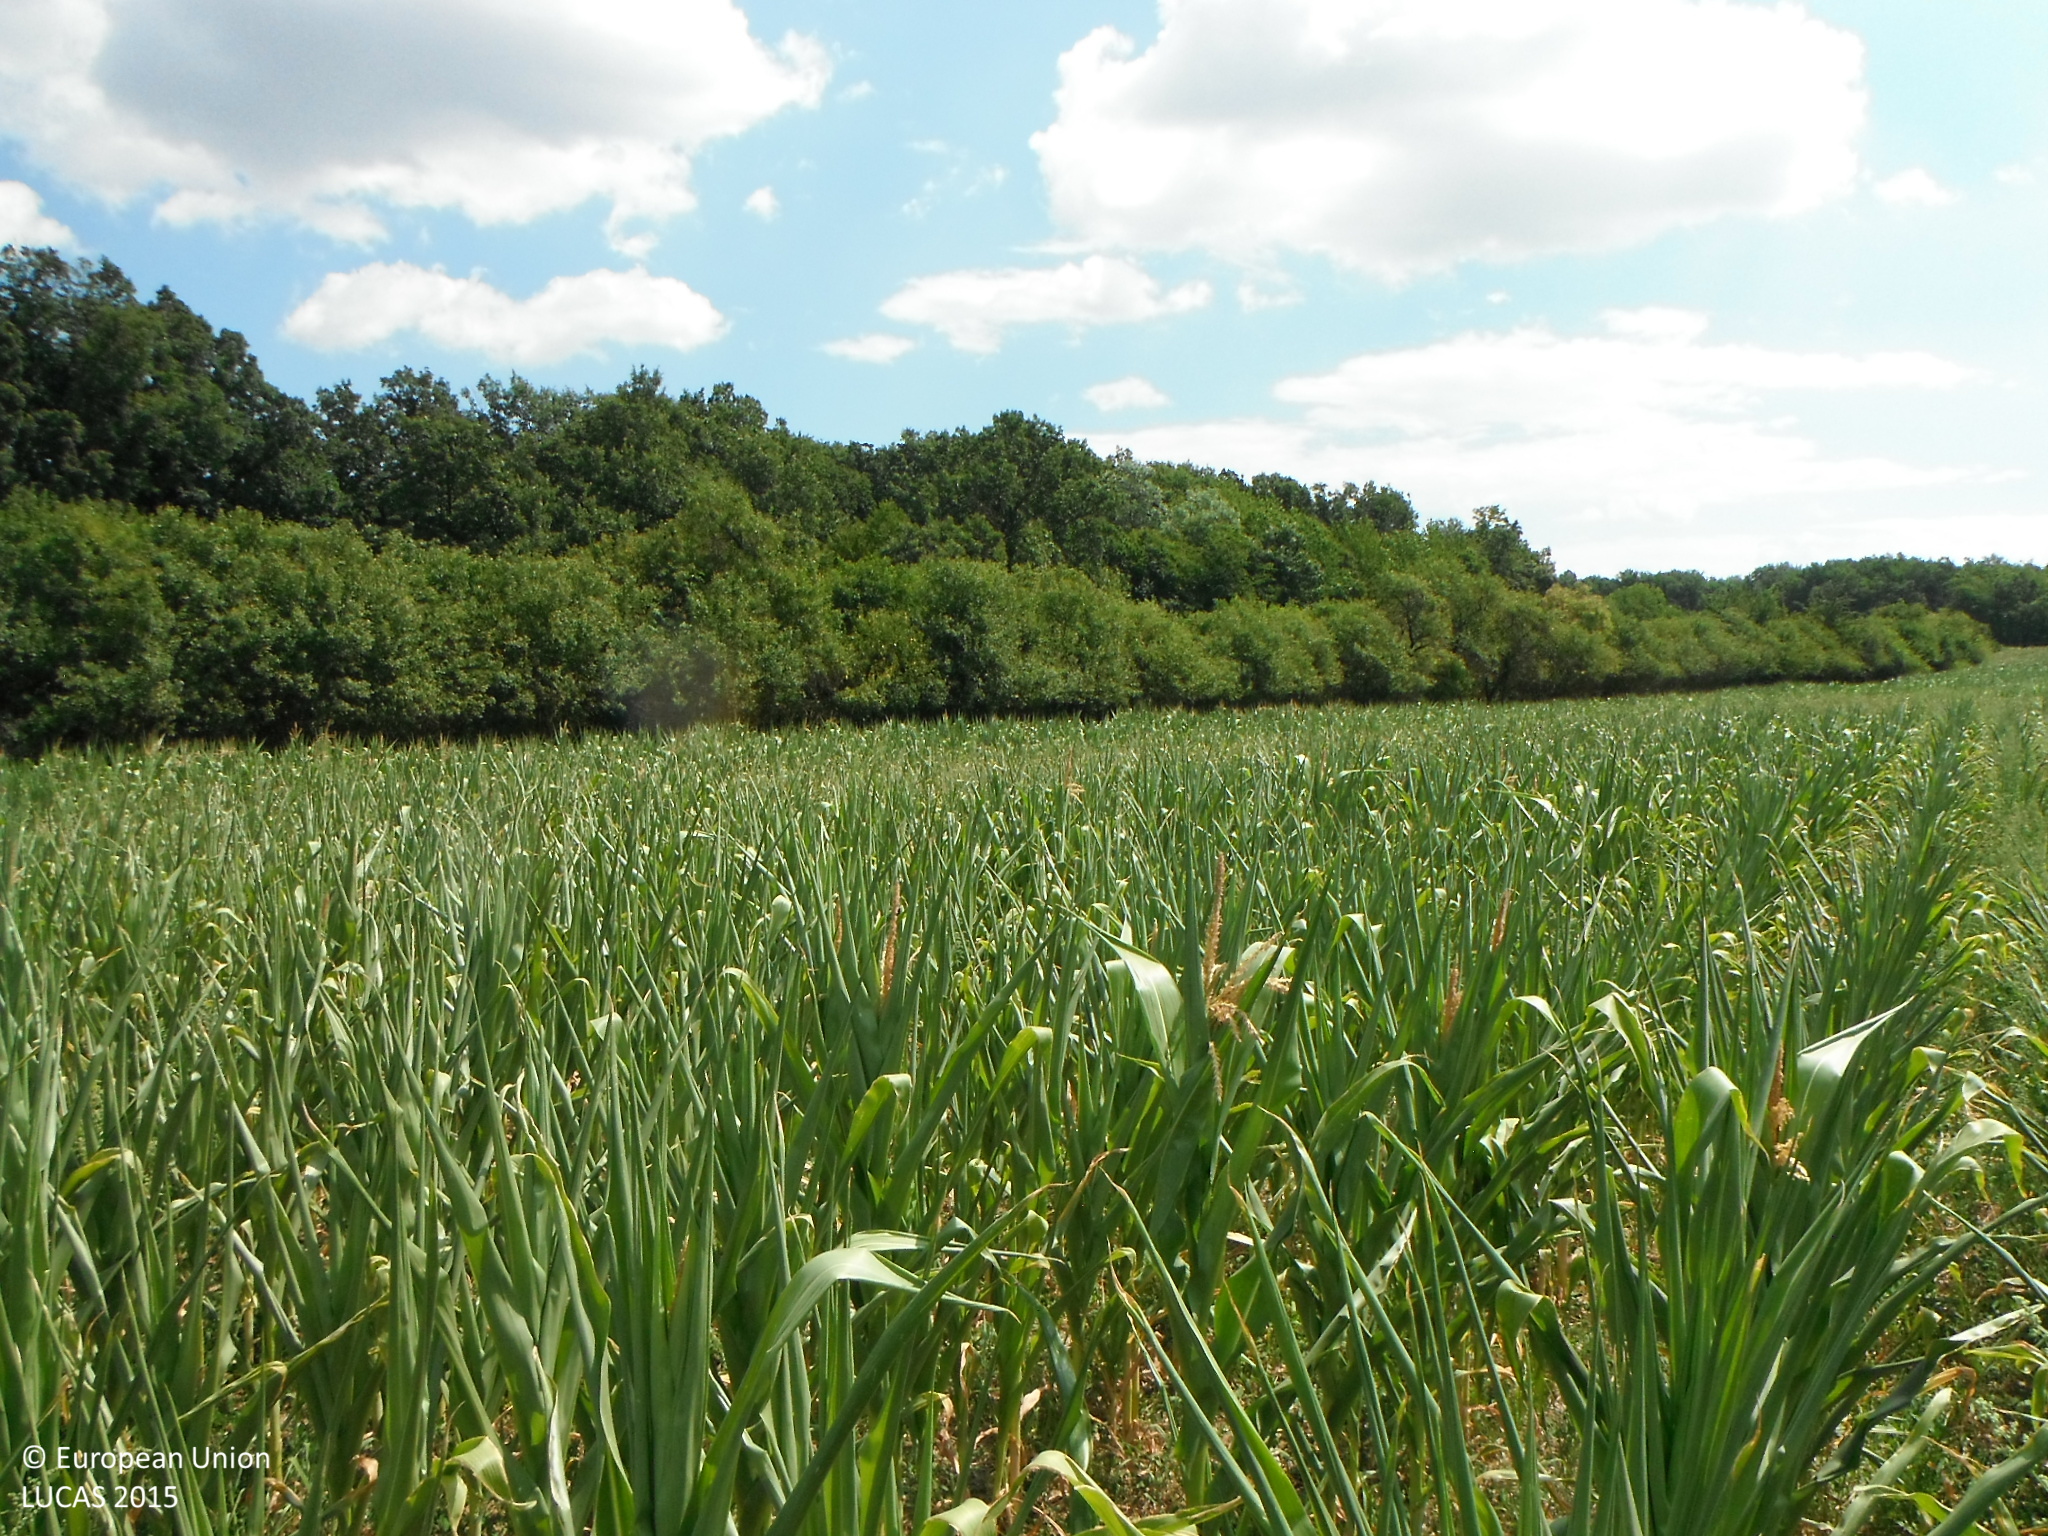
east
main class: Cropland
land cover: Maize
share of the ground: > 75 %
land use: Agriculture (excluding fallow land and kitchen gardens)
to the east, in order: Maize; Broadleaved woodland; Maize; Broadleaved woodland; Tracks; Broadleaved woodland
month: July
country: SK
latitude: 48.2975
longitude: 19.1201
